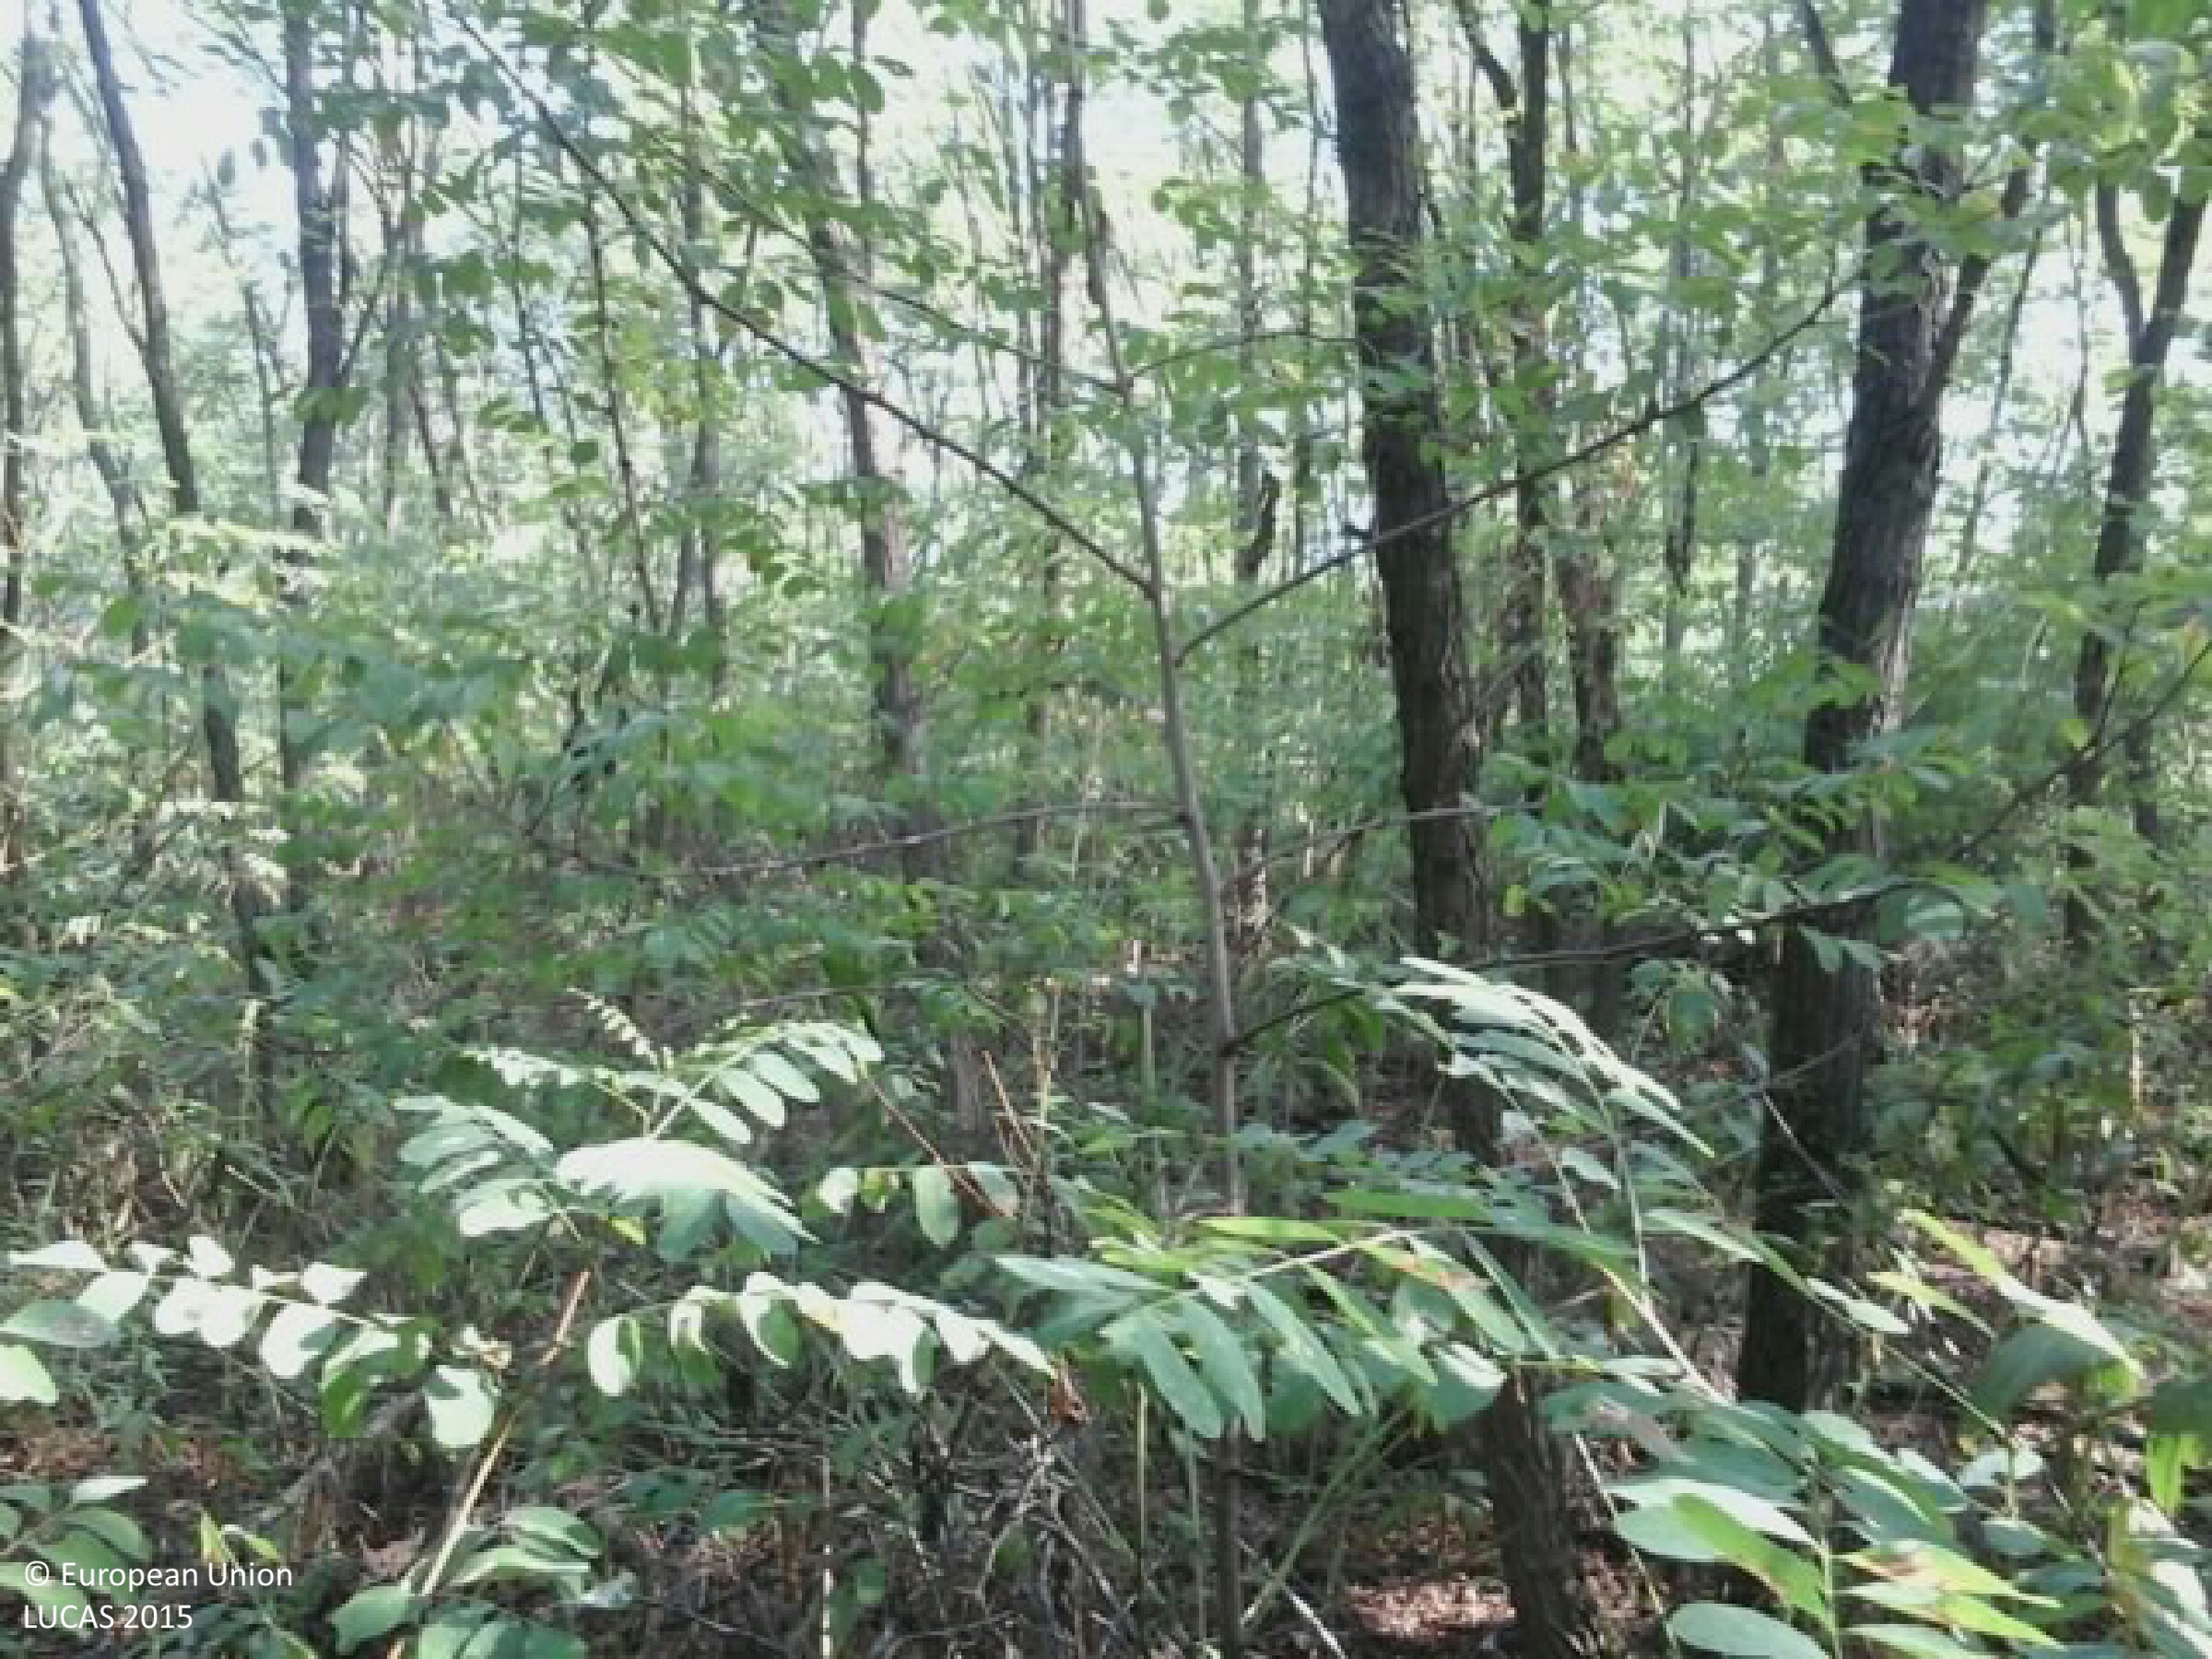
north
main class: Woodland
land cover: Broadleaved woodland
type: mesophytic deciduous forest
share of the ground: > 75 %
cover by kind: broadleaved forest trees 80 %, shrubs 20 %
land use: Forestry
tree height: > 5 m
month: August
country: HU
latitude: 47.2805
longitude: 19.3663
